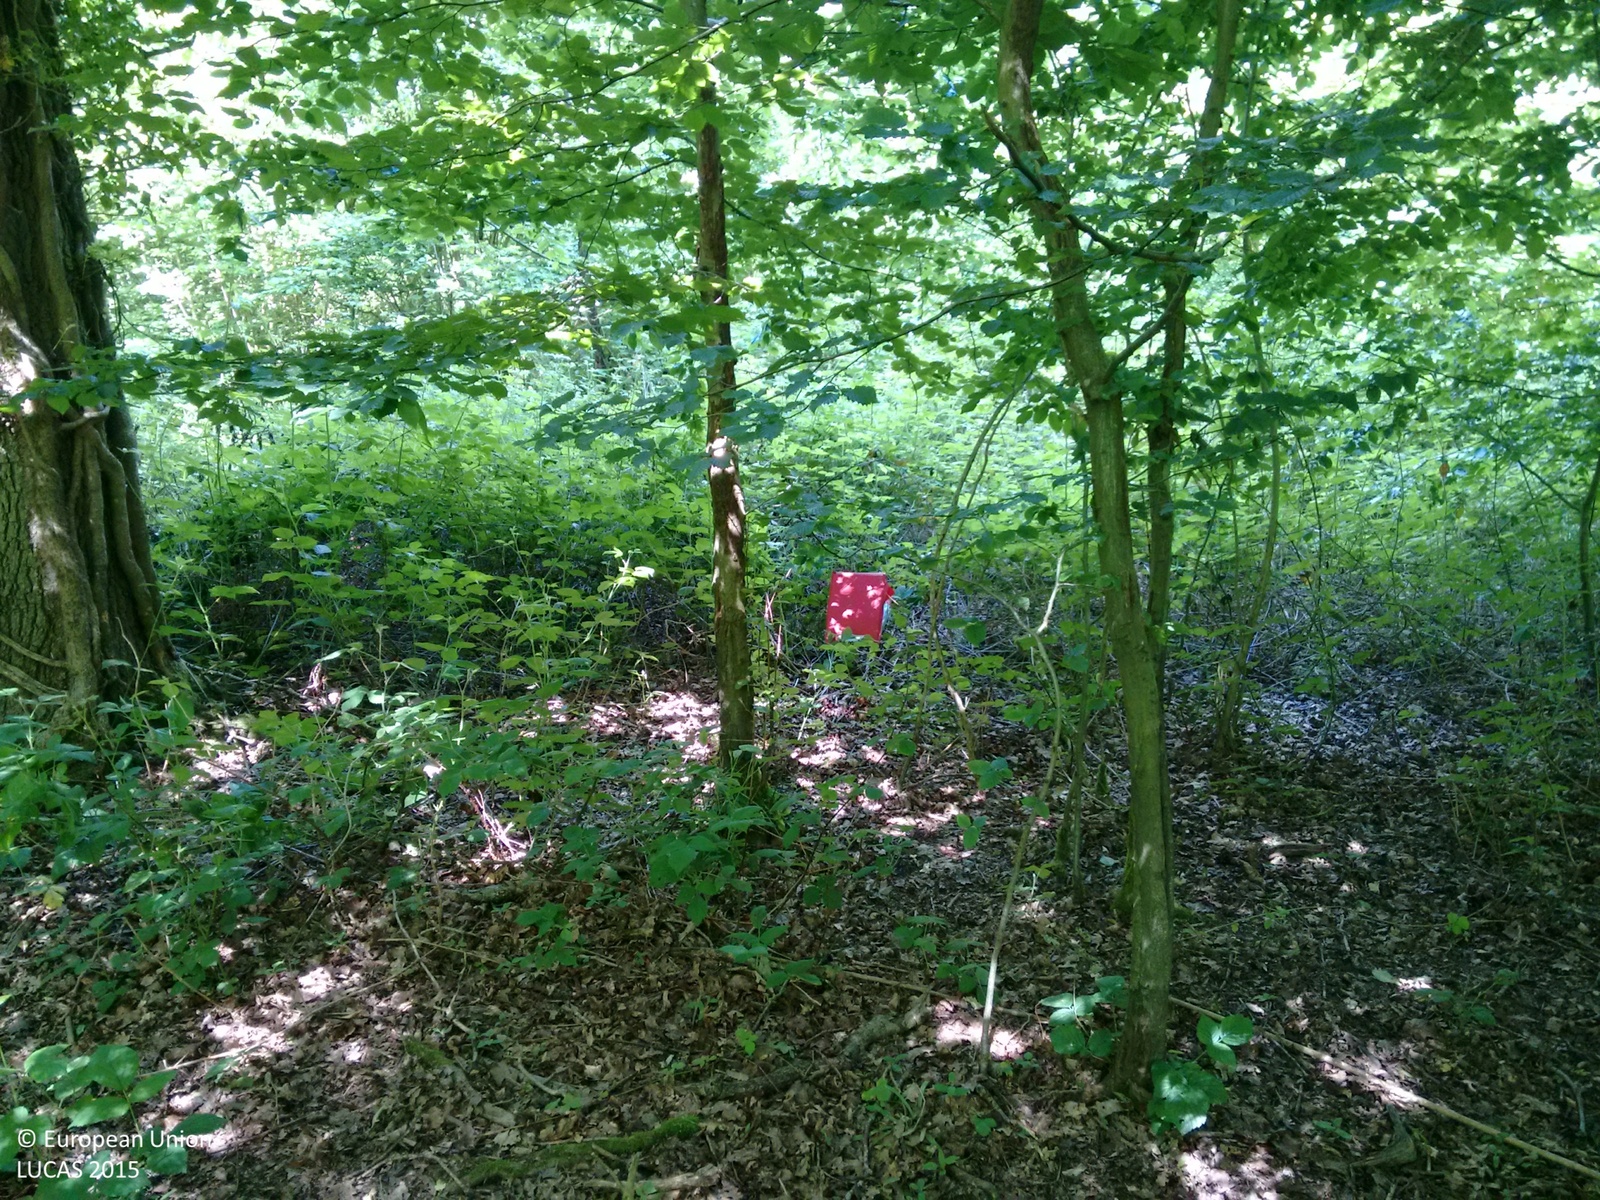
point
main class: Woodland
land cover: Broadleaved woodland
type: mesophytic deciduous forest
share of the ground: > 75 %
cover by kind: broadleaved forest trees 60 %, shrubs 35 %, herbaceous plants 5 %
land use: Forestry
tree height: > 5 m
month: June
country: GB
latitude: 50.9578
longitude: 0.6485
